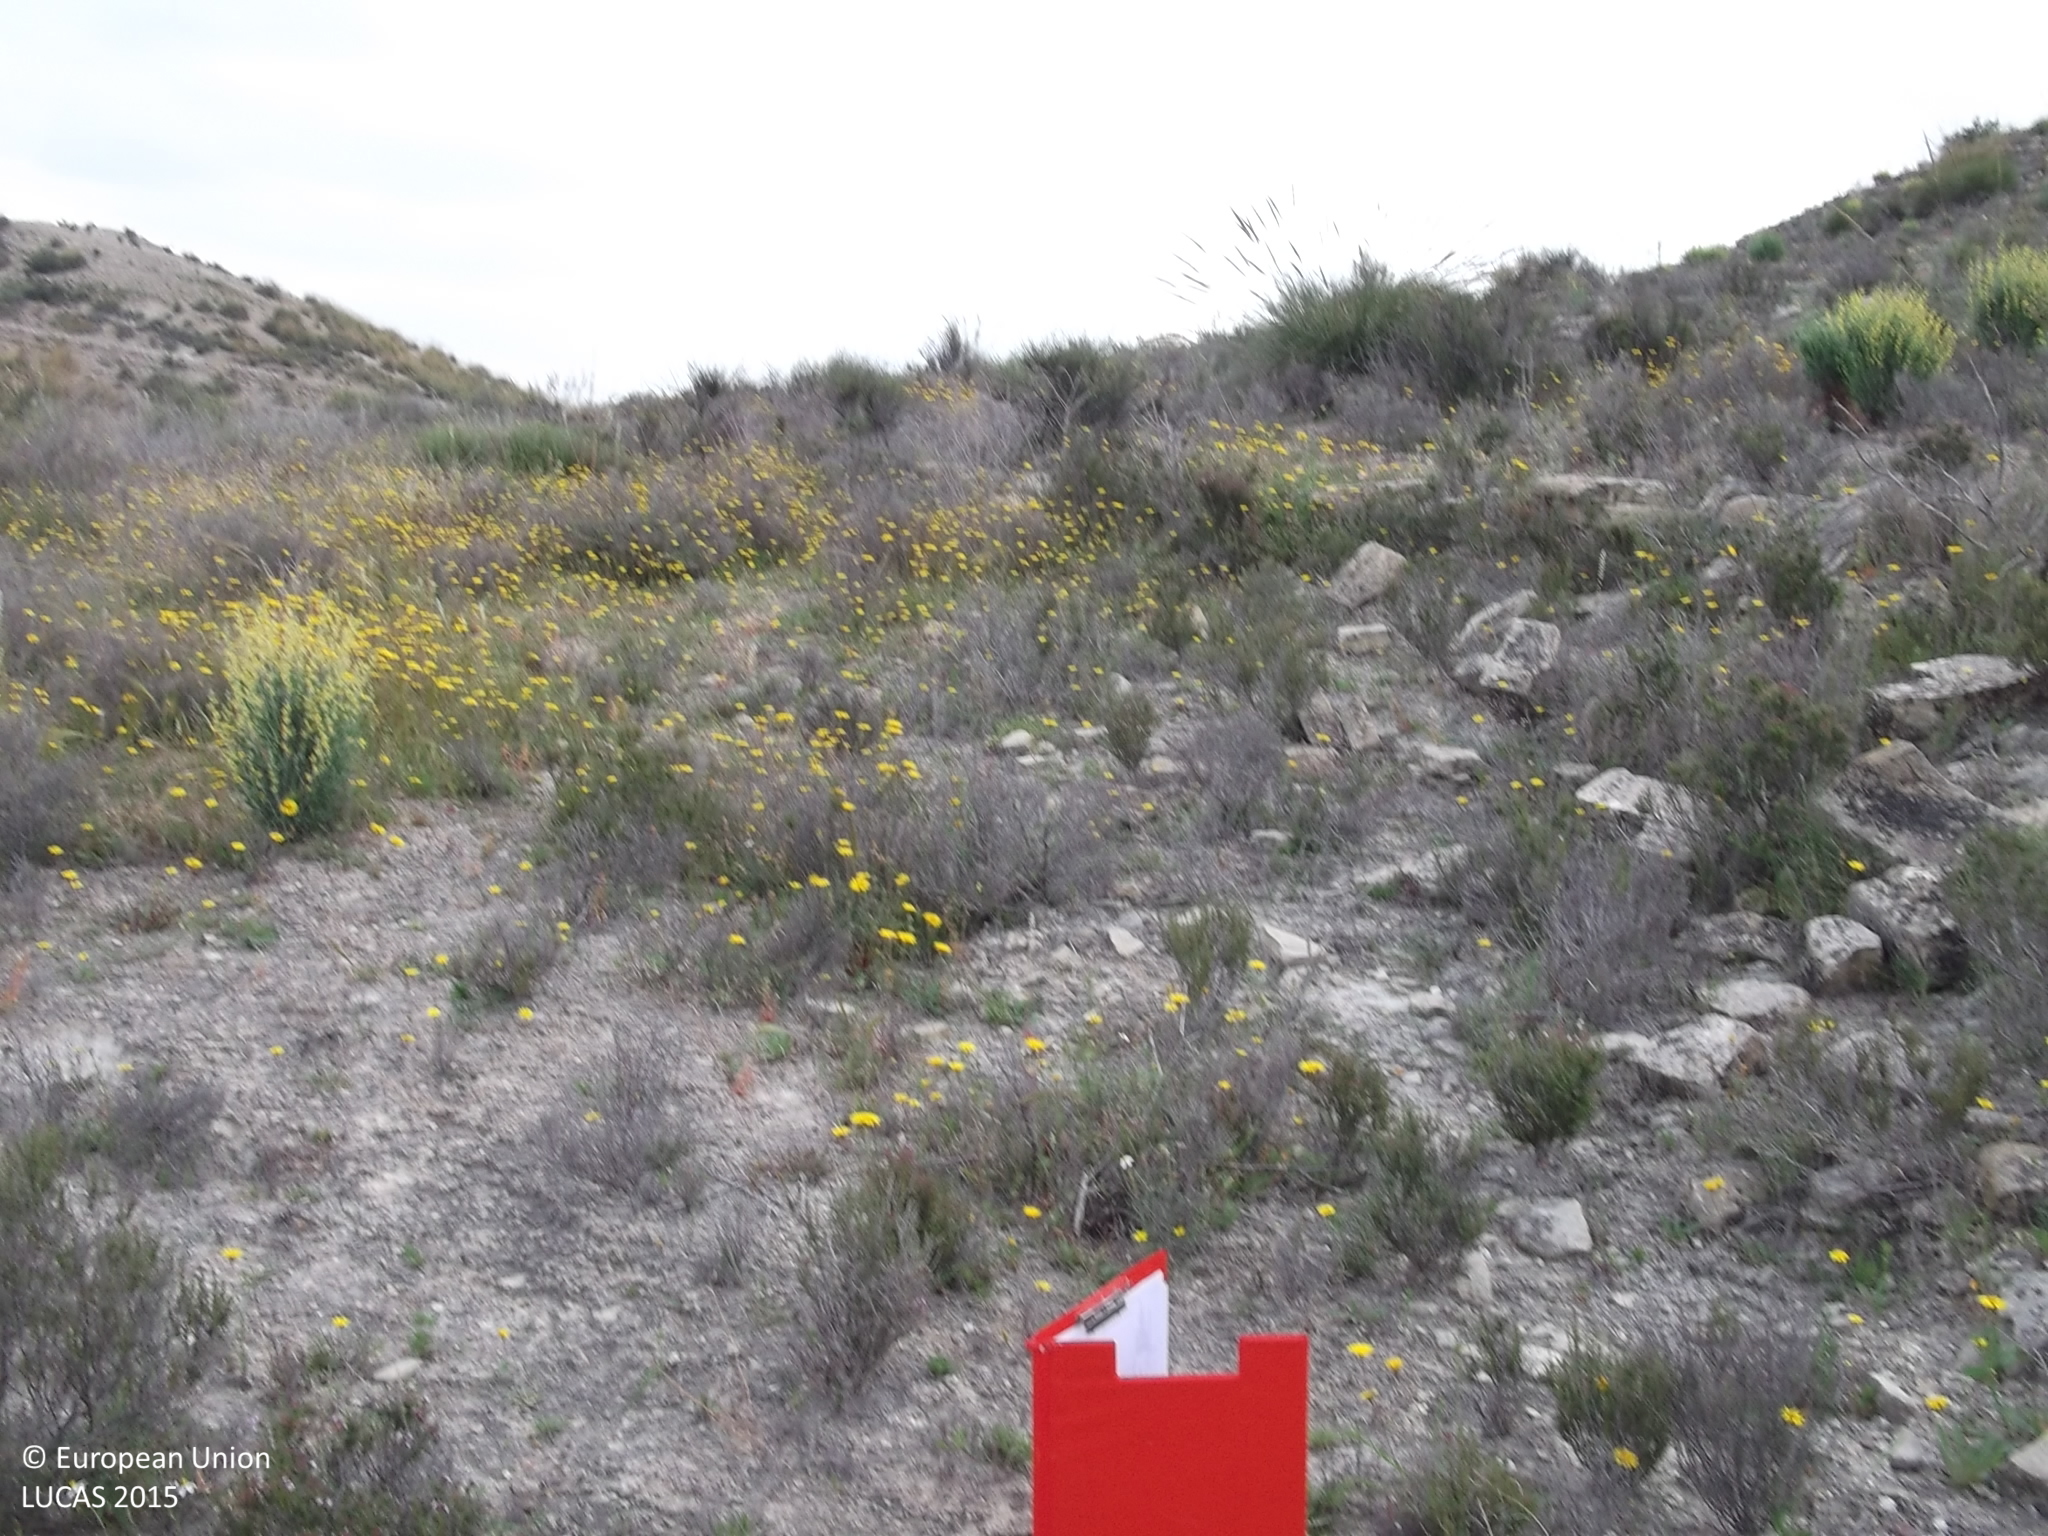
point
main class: Shrubland
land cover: Shrubland without tree cover
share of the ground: 25 - 50 %
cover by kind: herbaceous plants 60 %, shrubs 40 %
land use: Semi-natural and natural areas not in use
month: April
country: ES
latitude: 37.9767
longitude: -1.3806
